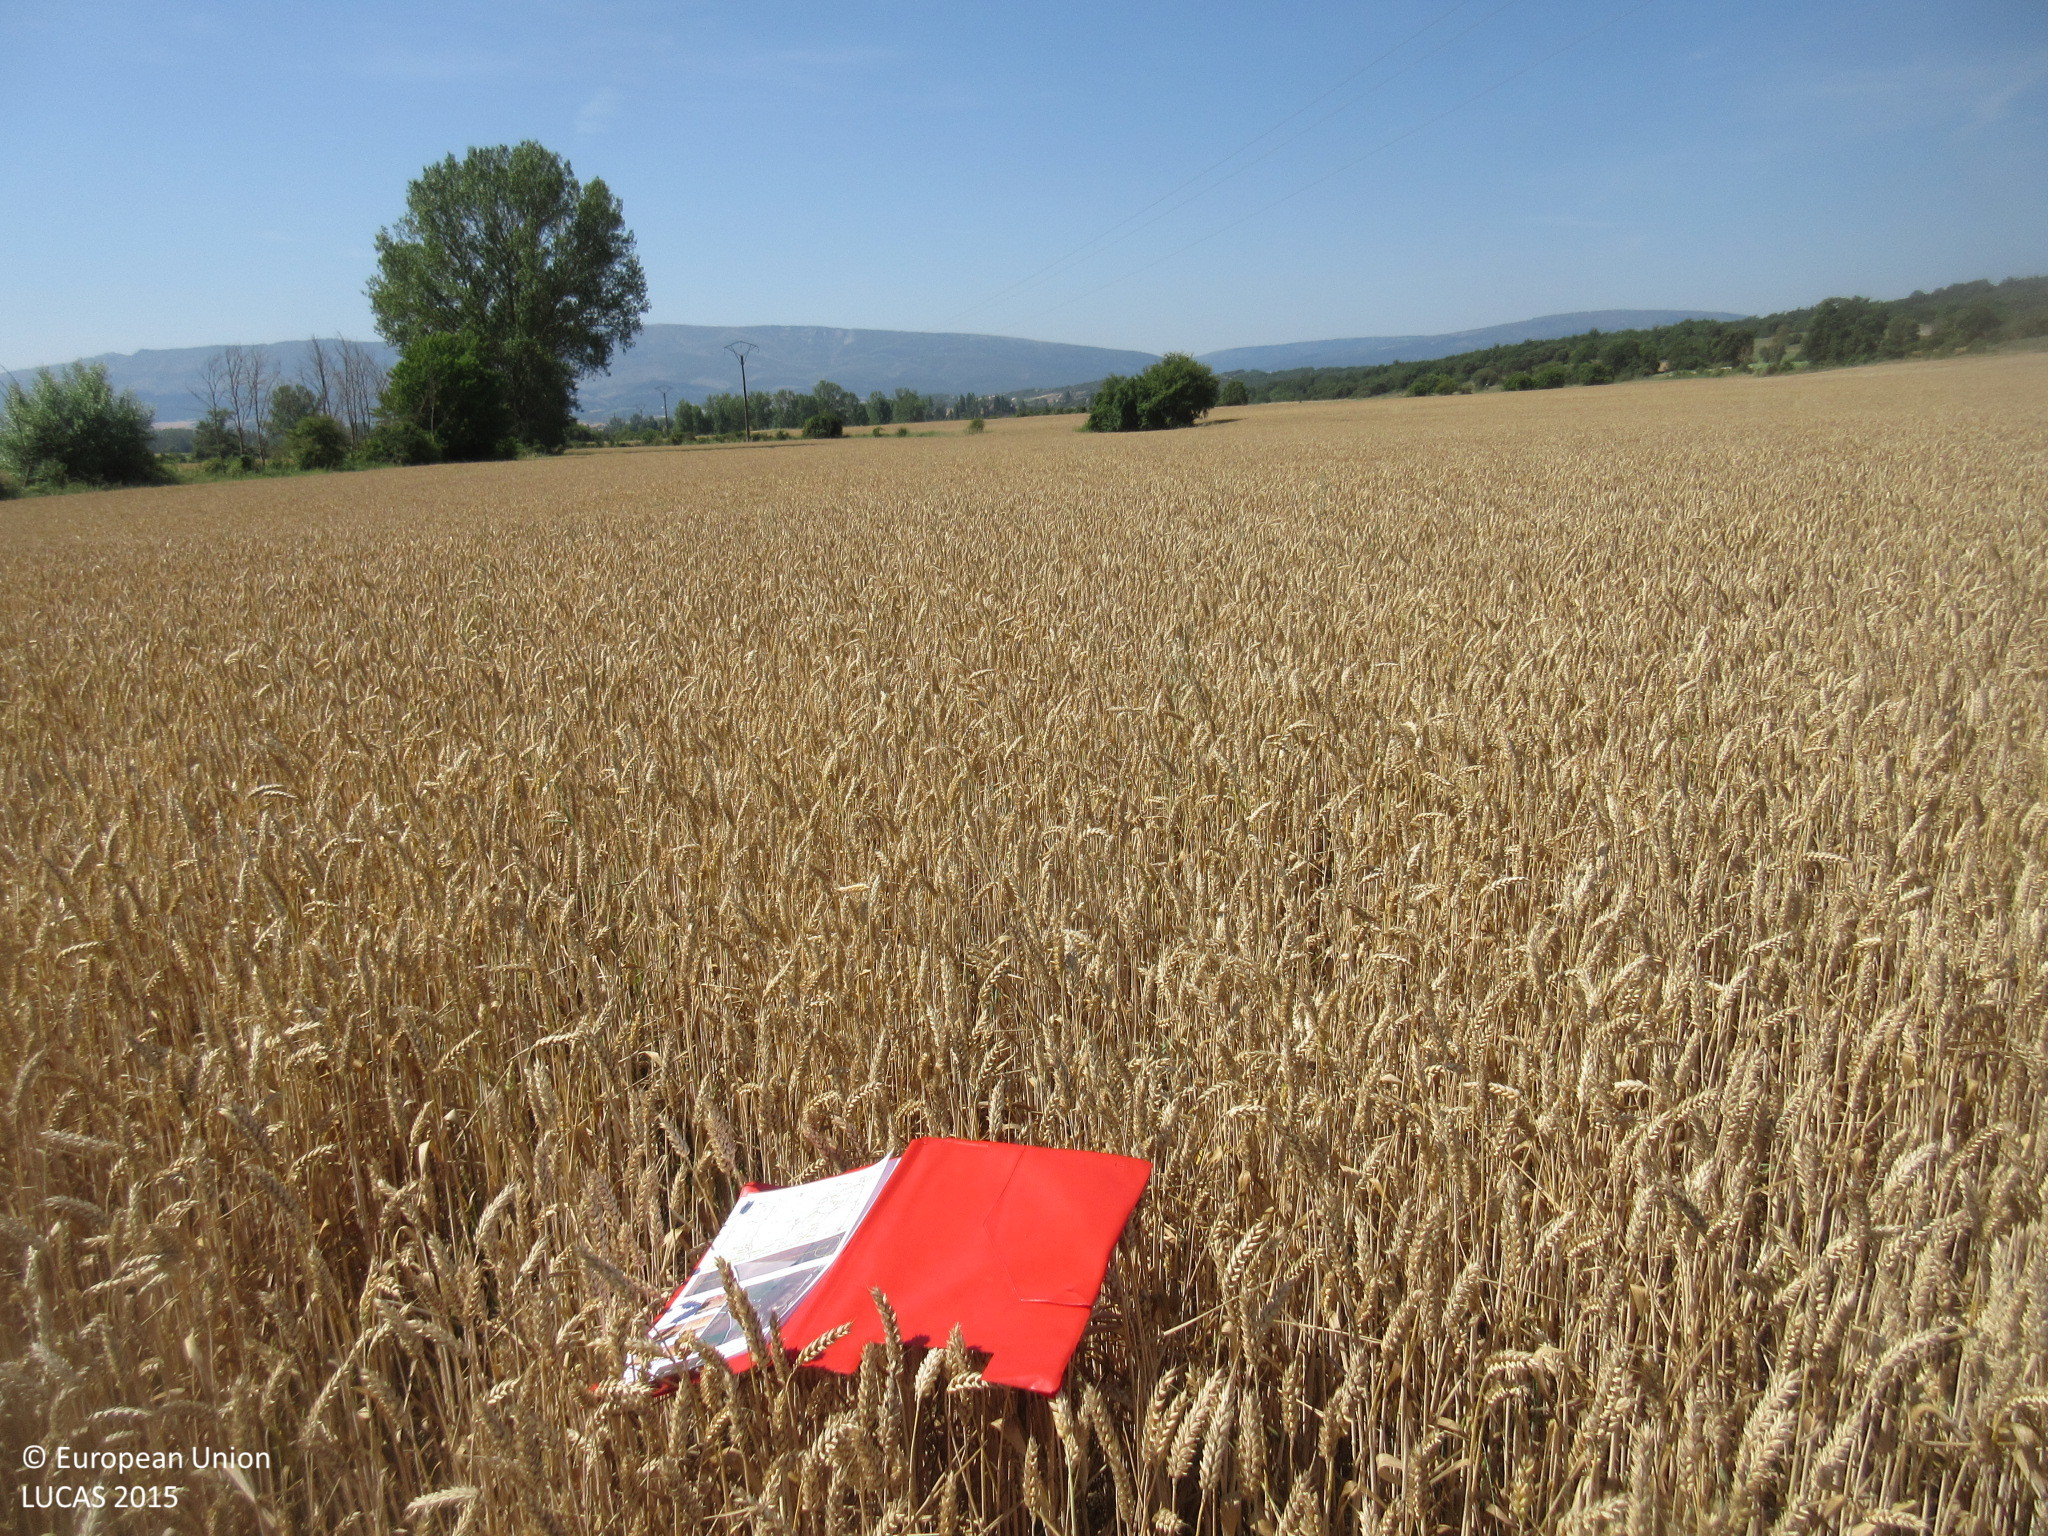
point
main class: Cropland
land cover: Common wheat
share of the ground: > 75 %
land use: Agriculture (excluding fallow land and kitchen gardens)
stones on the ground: < 10 %
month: July
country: ES
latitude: 42.9685
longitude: -3.5141
